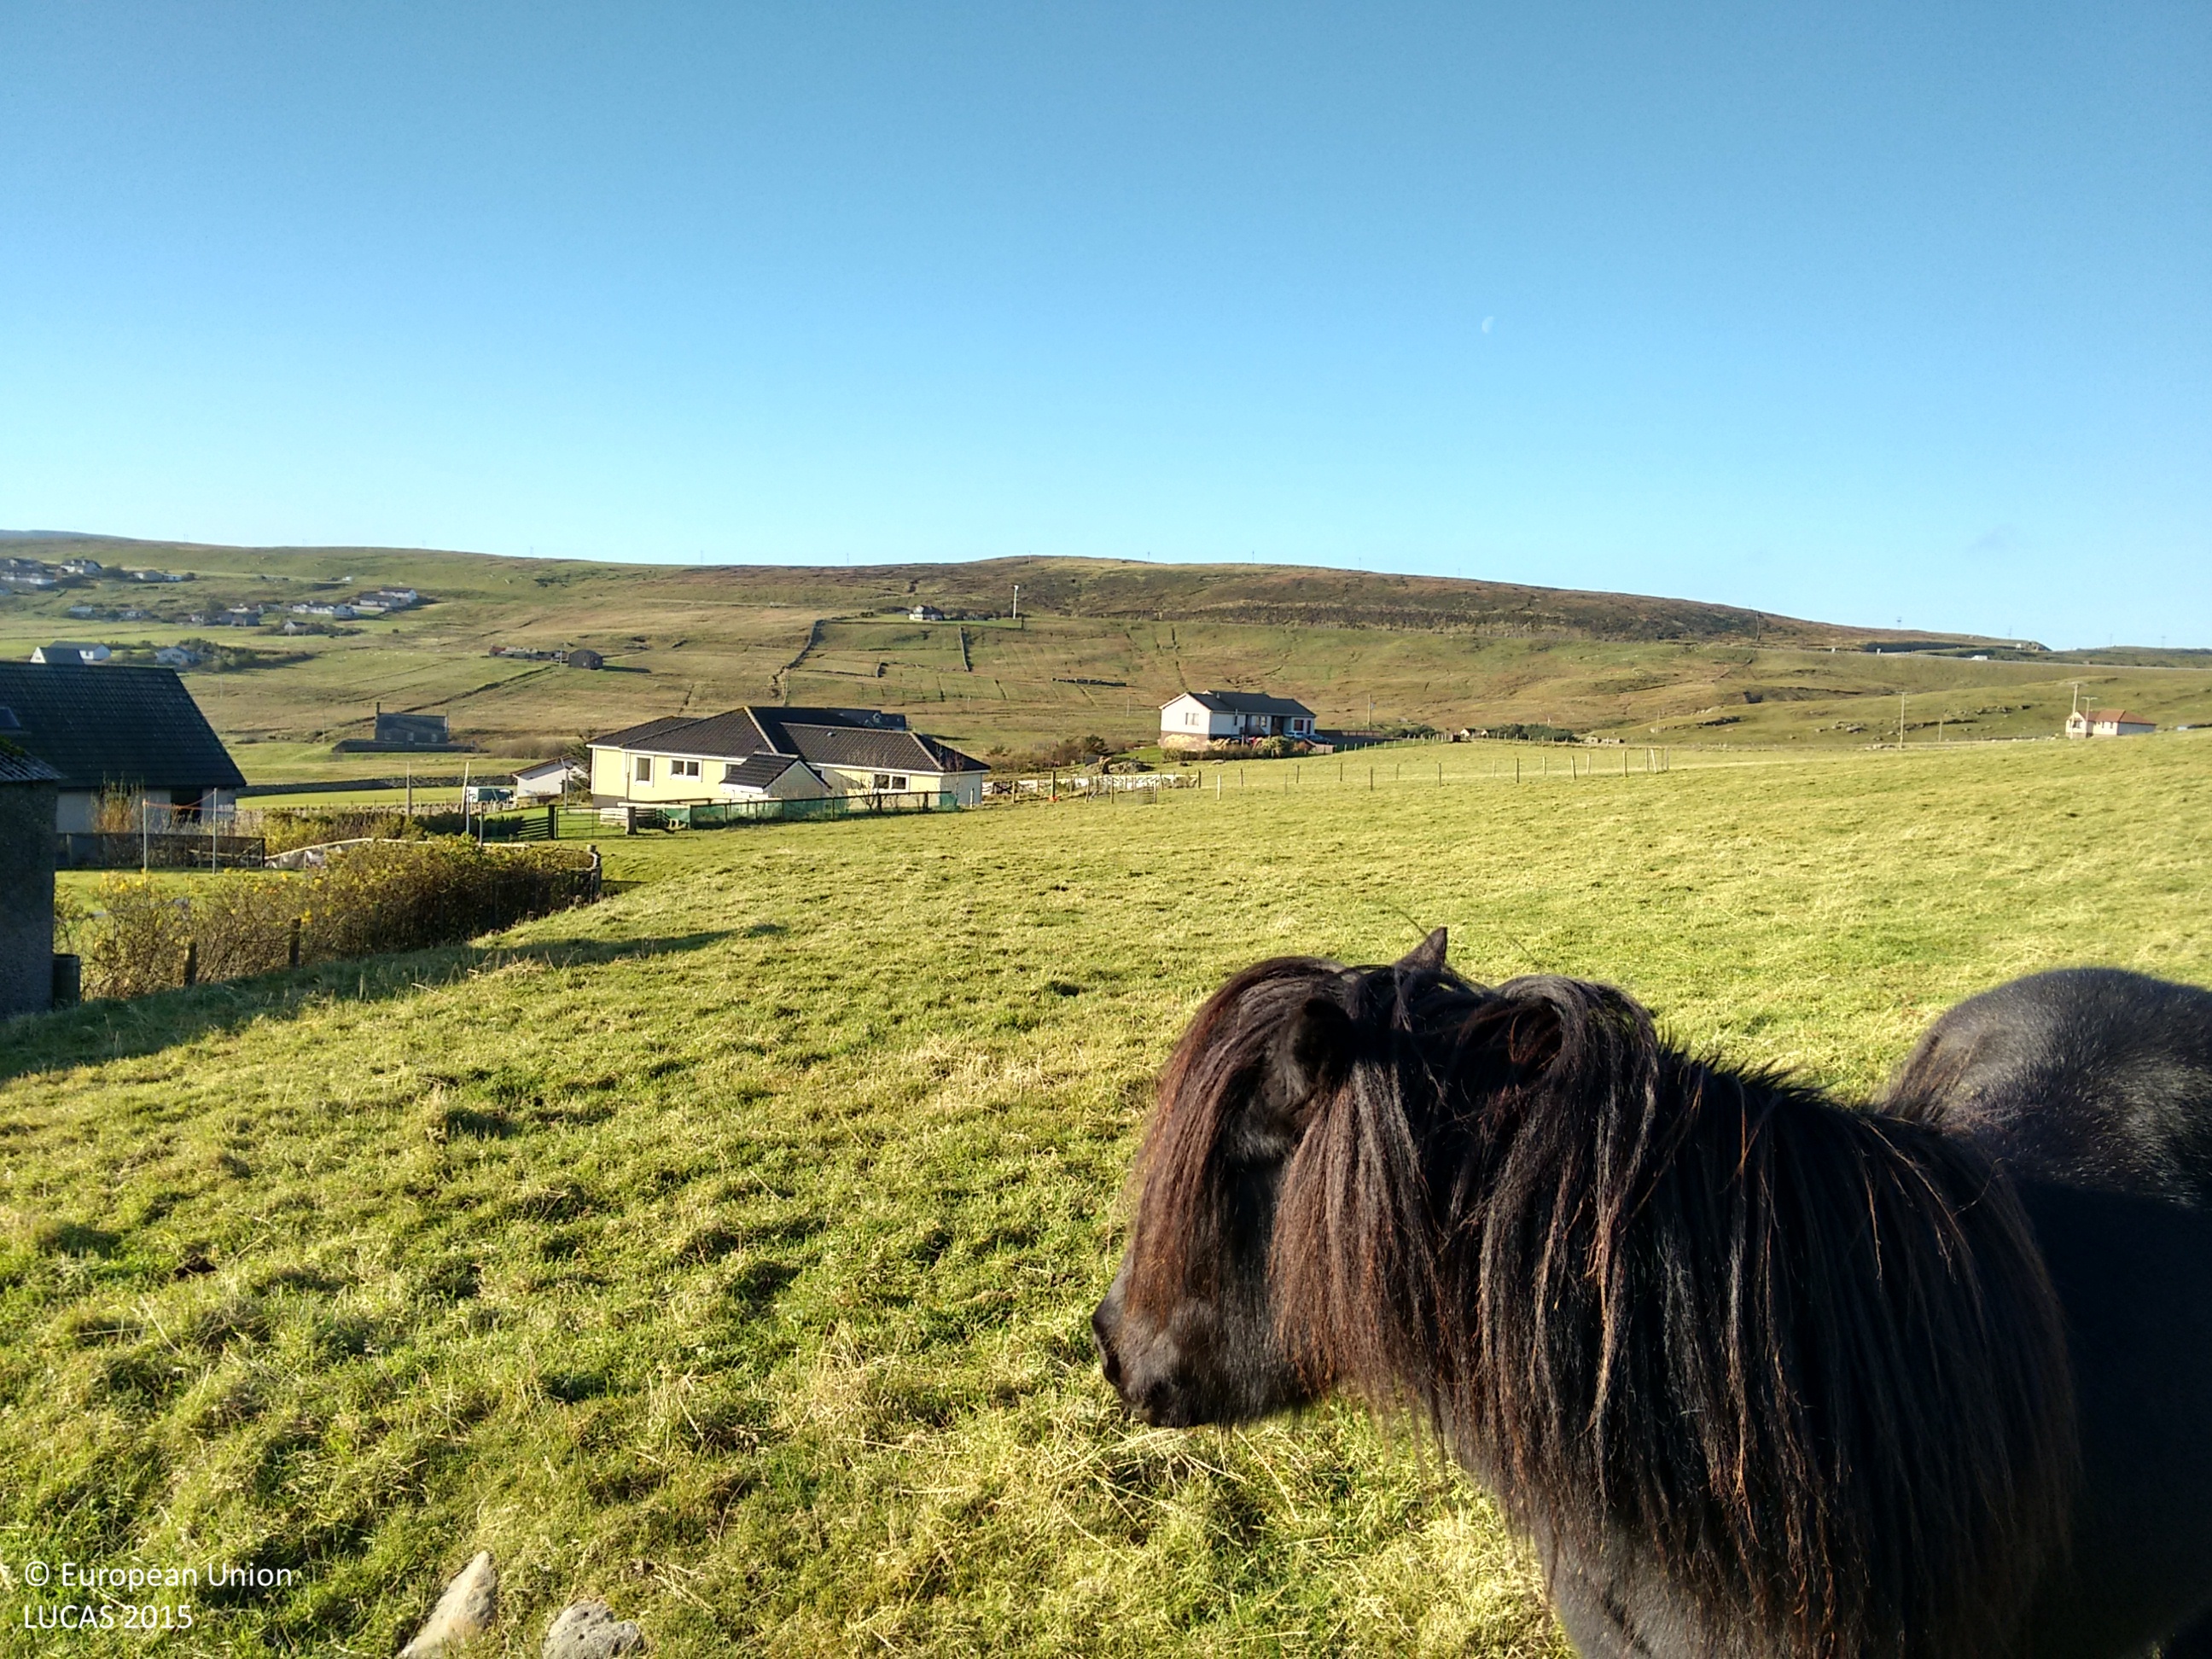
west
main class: Grassland
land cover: Grassland without tree/shrub cover
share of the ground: > 75 %
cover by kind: herbaceous plants 100 %
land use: Agriculture (excluding fallow land and kitchen gardens)
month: November
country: GB
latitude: 60.1338
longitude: -1.1990
